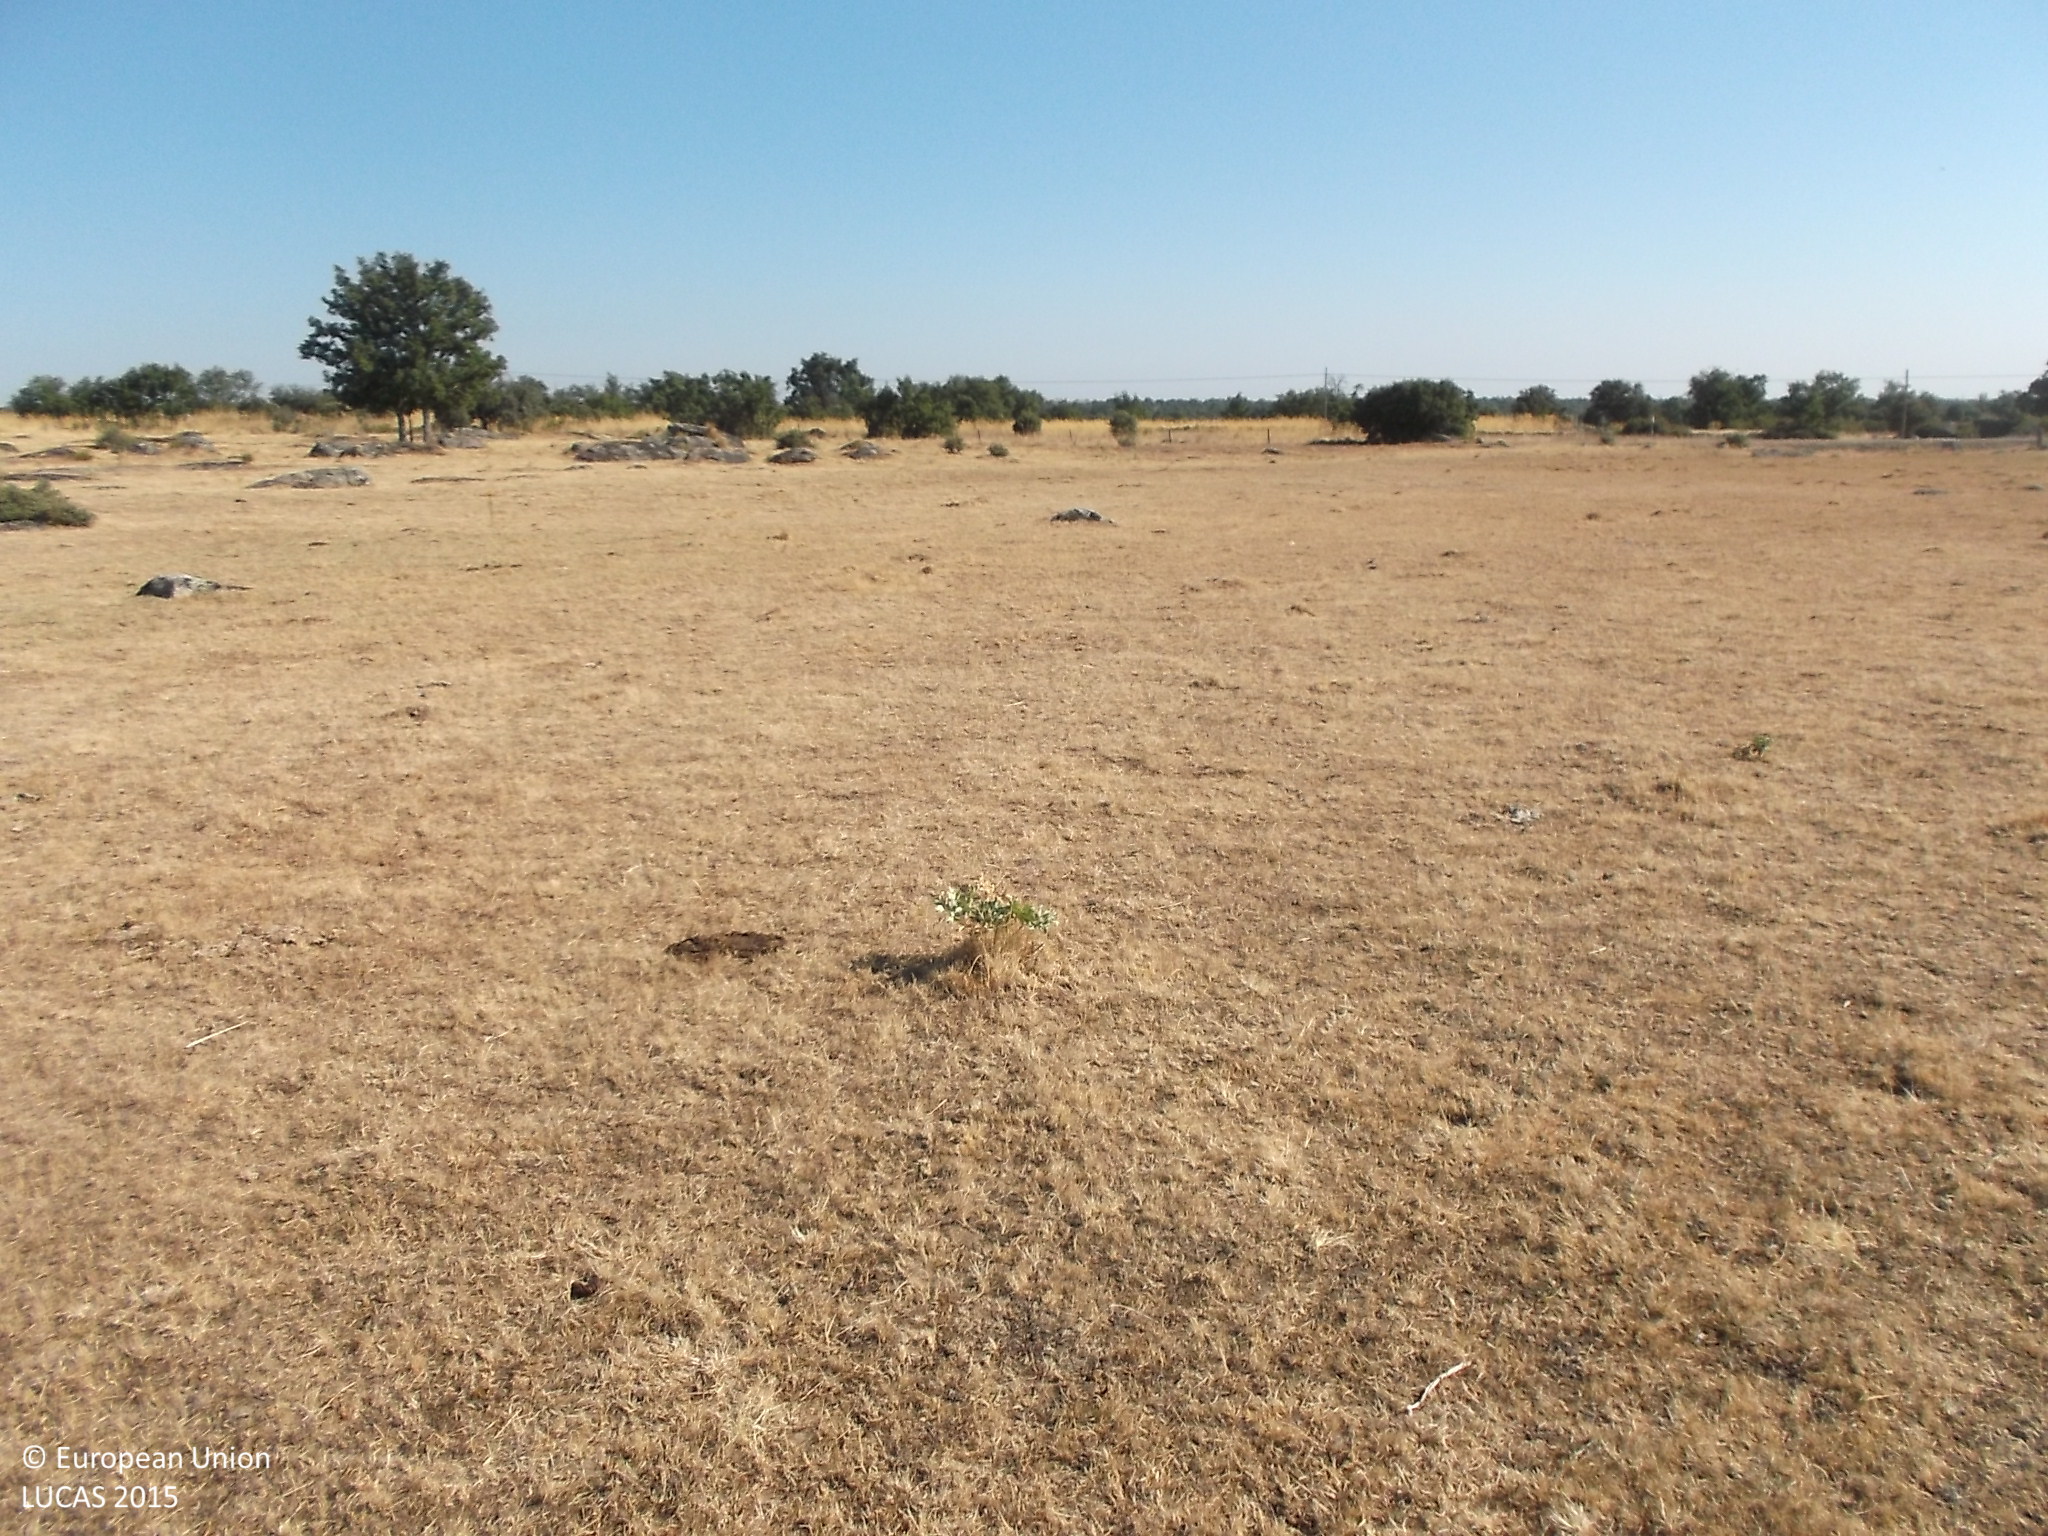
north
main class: Grassland
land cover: Grassland without tree/shrub cover
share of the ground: > 75 %
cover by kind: herbaceous plants 100 %
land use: Agriculture (excluding fallow land and kitchen gardens)
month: July
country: ES
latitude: 41.3329
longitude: -6.0175
